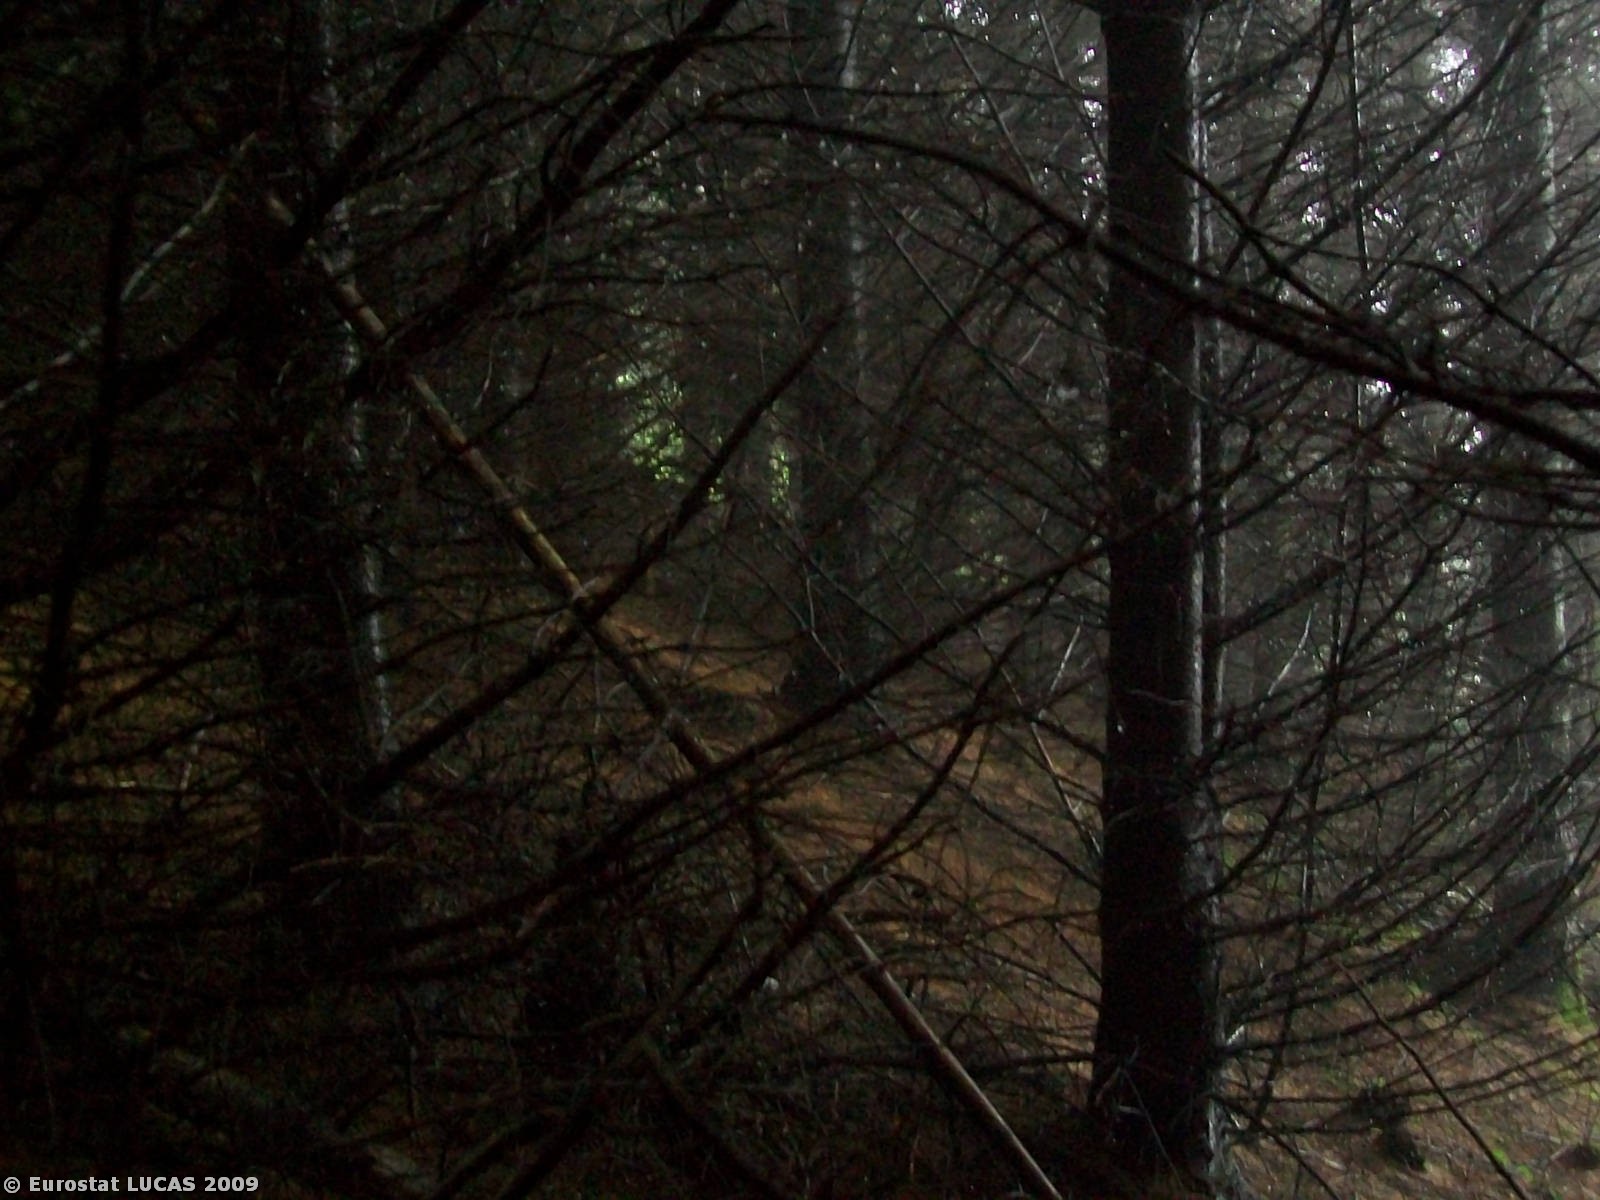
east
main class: Woodland
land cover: Coniferous woodland
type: plantations and self-sown exotic forest
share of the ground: > 75 %
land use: Forestry
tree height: > 5 m
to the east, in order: Coniferous woodland; Spontaneously vegetated surfaces; Coniferous woodland; Broadleaved woodland; Coniferous woodland; Broadleaved woodland; Grassland without tree/shrub cover; Coniferous woodland; Broadleaved woodland; Coniferous woodland
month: July
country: GB
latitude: 54.7660
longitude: -6.1693
